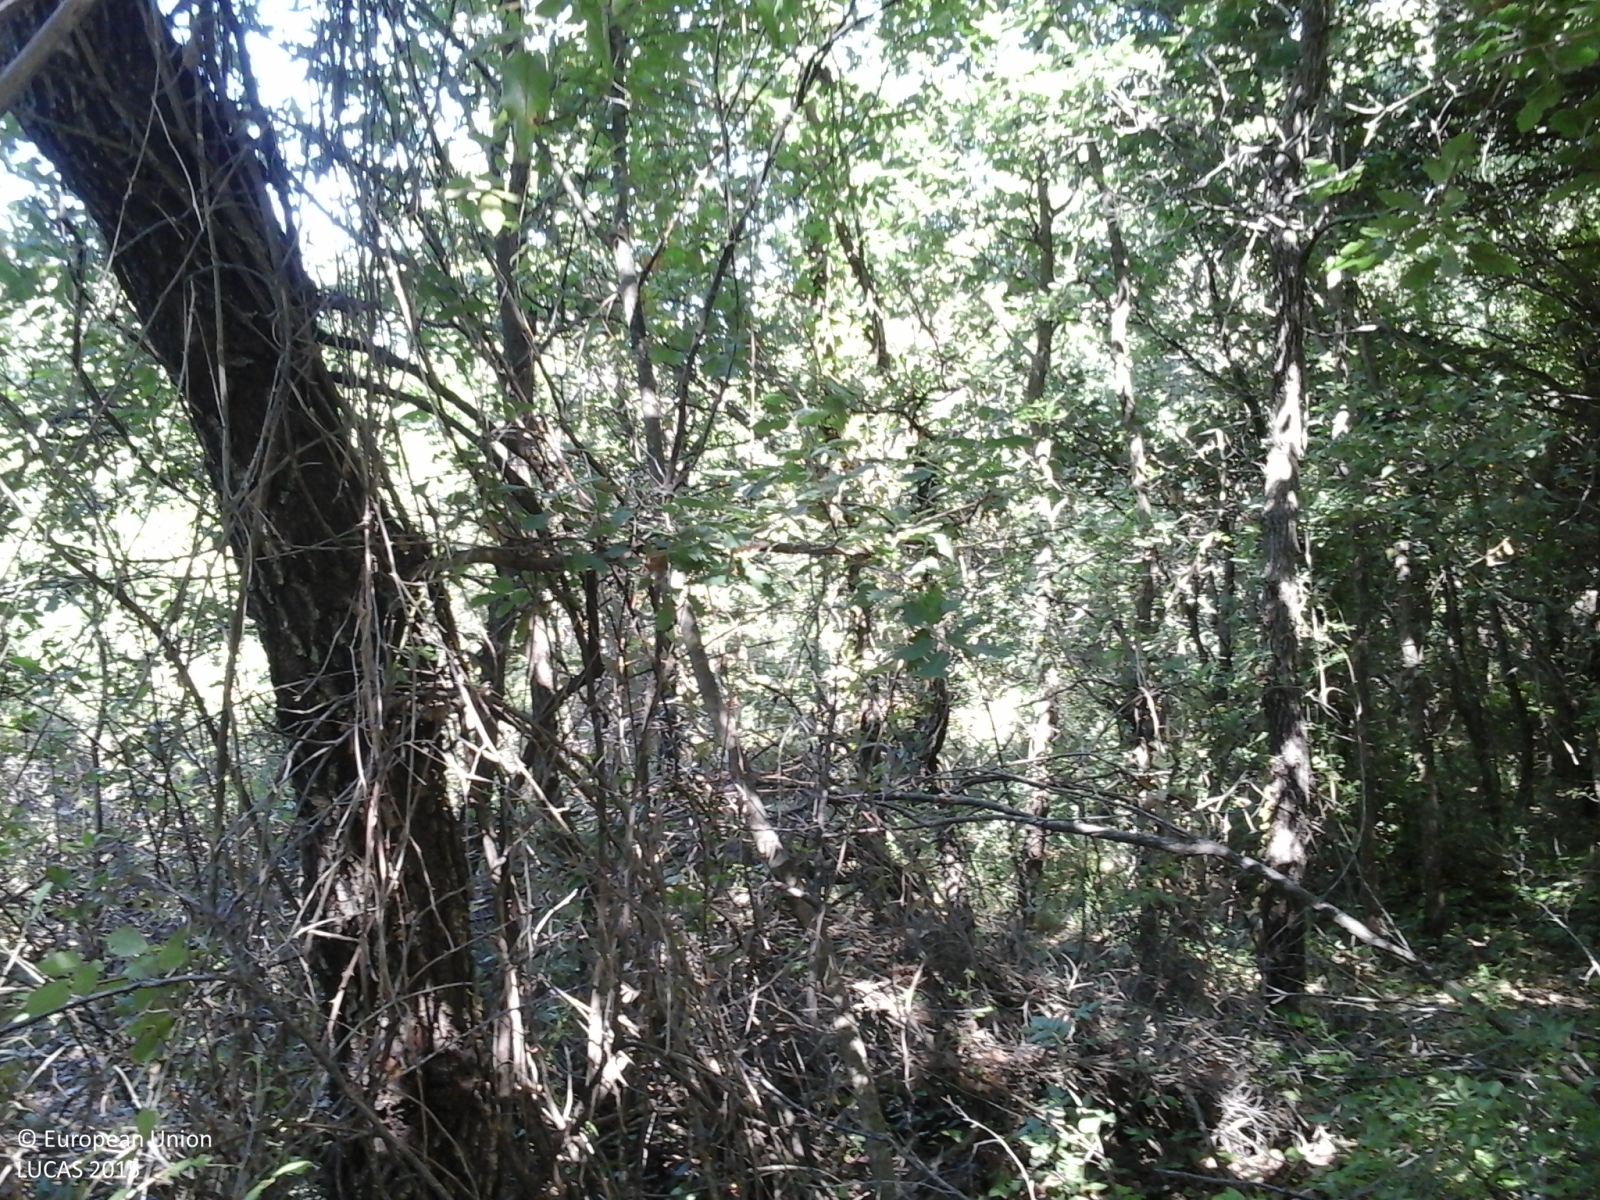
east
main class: Woodland
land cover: Broadleaved woodland
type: thermophilous deciduous forest
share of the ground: > 75 %
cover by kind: broadleaved forest trees 90 %, shrubs 5 %, herbaceous plants 5 %
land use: Forestry
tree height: < 5 m
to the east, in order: Broadleaved woodland; Tracks; Broadleaved woodland; Spontaneously vegetated surfaces; Grassland with sparse tree/shrub cover; Other fruit trees and berries; Broadleaved woodland; Tracks; Broadleaved woodland; Permanent crops (only in case pi)
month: May
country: IT
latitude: 37.9879
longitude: 14.0594
